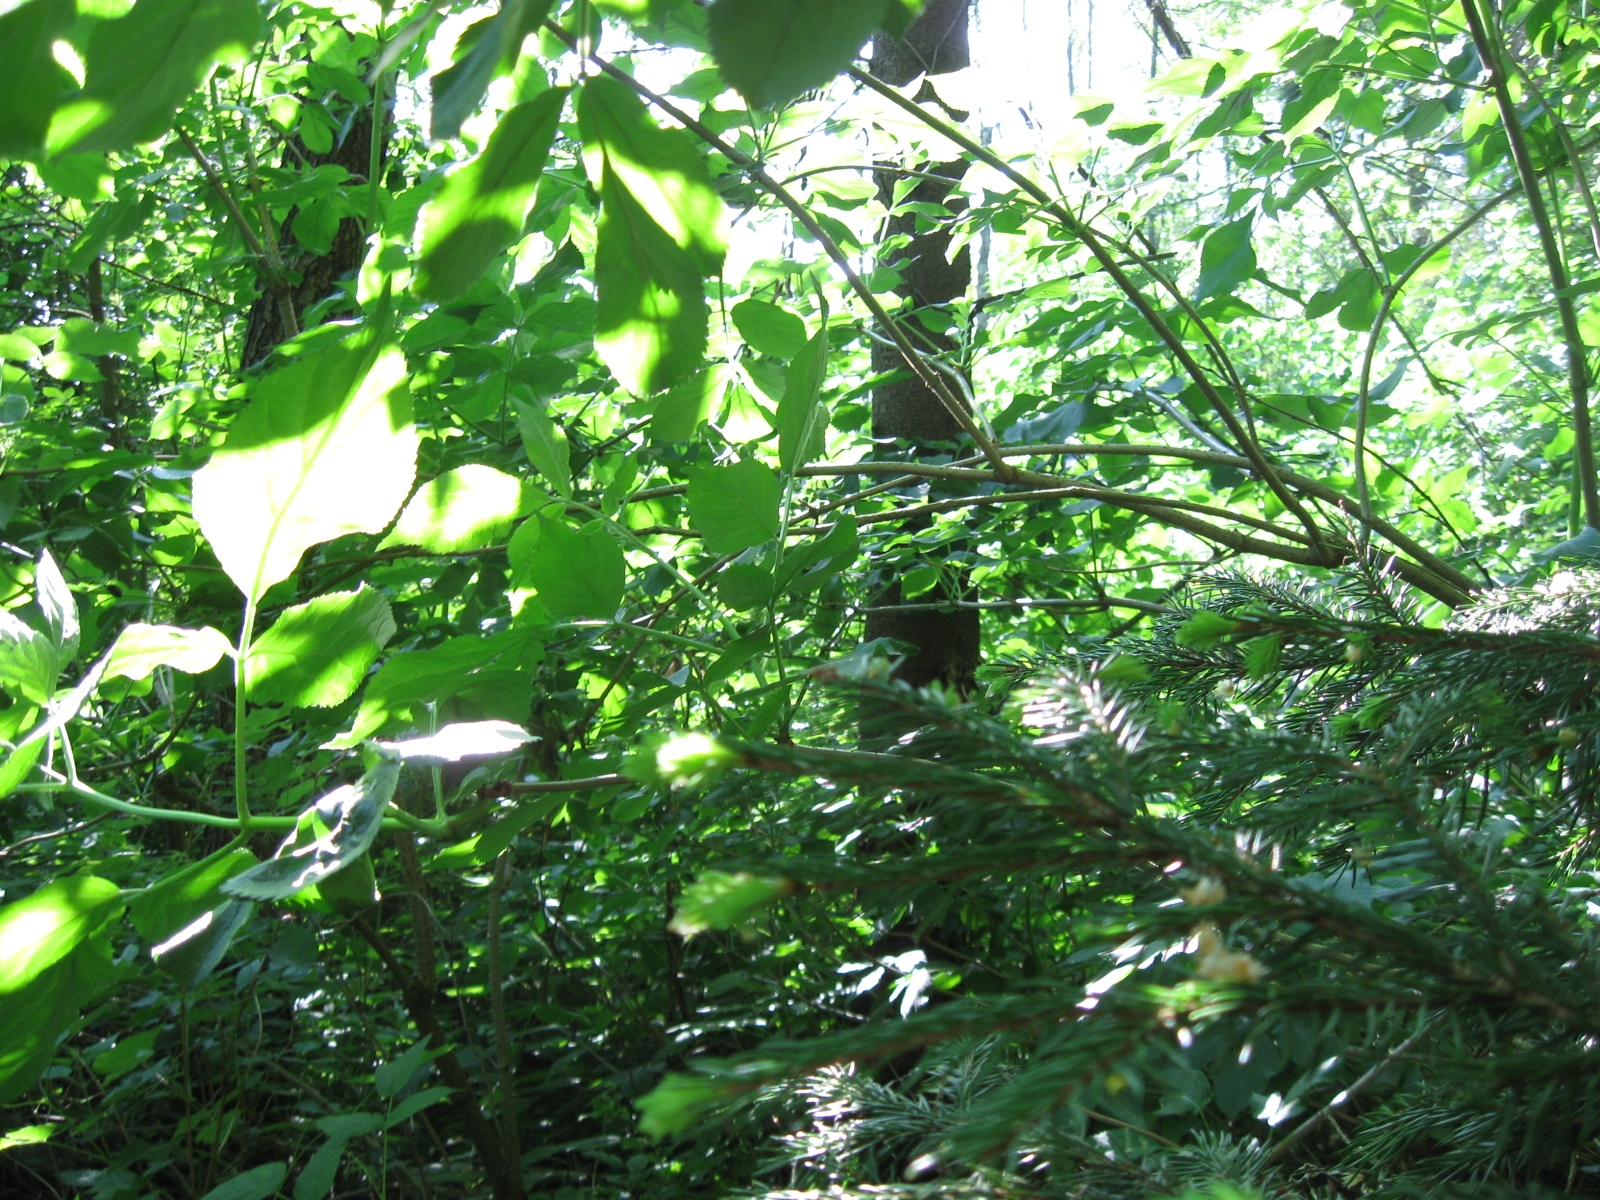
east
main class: Woodland
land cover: Spruce dominated mixed woodland
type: hemiboreal forest and nemoral coniferous forest and mixed broadleaved-coniferous forest
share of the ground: > 75 %
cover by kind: broadleaved forest trees 60 %, coniferous forest trees 30 %, herbaceous plants 10 %
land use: Forestry
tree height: > 5 m
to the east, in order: Spruce dominated mixed woodland; Rivers and streams; Broadleaved woodland; Grassland with sparse tree/shrub cover; Grassland without tree/shrub cover; Temporary grasslands; Inland marshes; Grassland with sparse tree/shrub cover; Common wheat
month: June
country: LT
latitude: 54.2885
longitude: 23.6187
